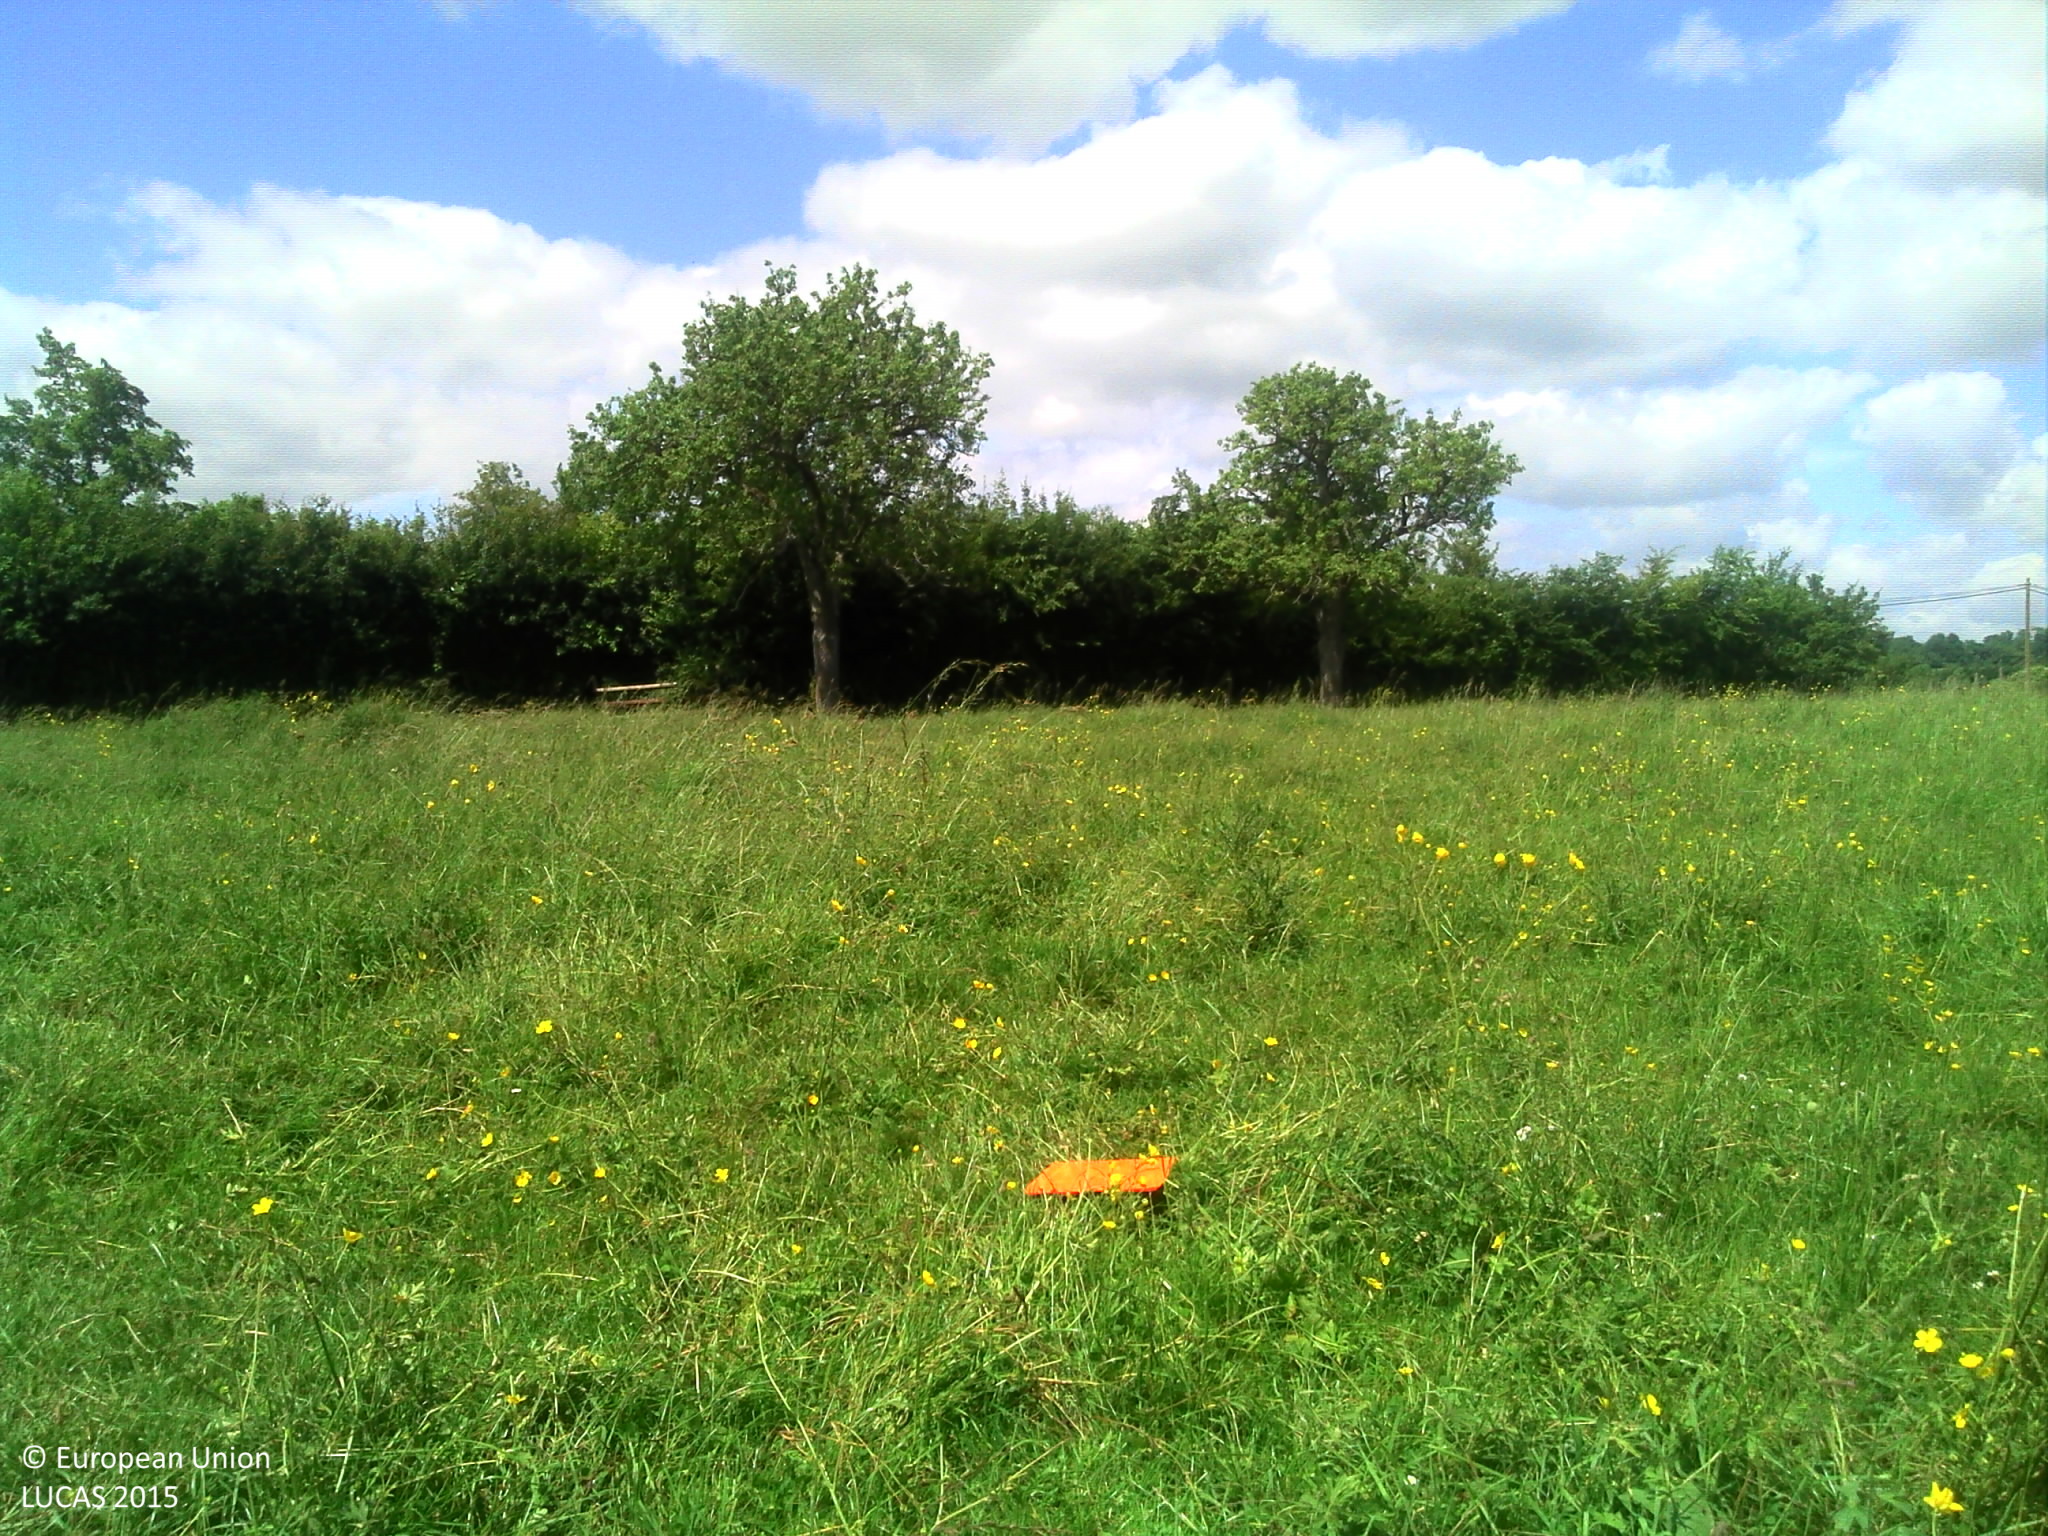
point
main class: Grassland
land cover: Grassland without tree/shrub cover
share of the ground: > 75 %
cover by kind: herbaceous plants 95 %
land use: Agriculture (excluding fallow land and kitchen gardens)
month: June
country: FR
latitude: 48.8763
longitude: 0.0299
